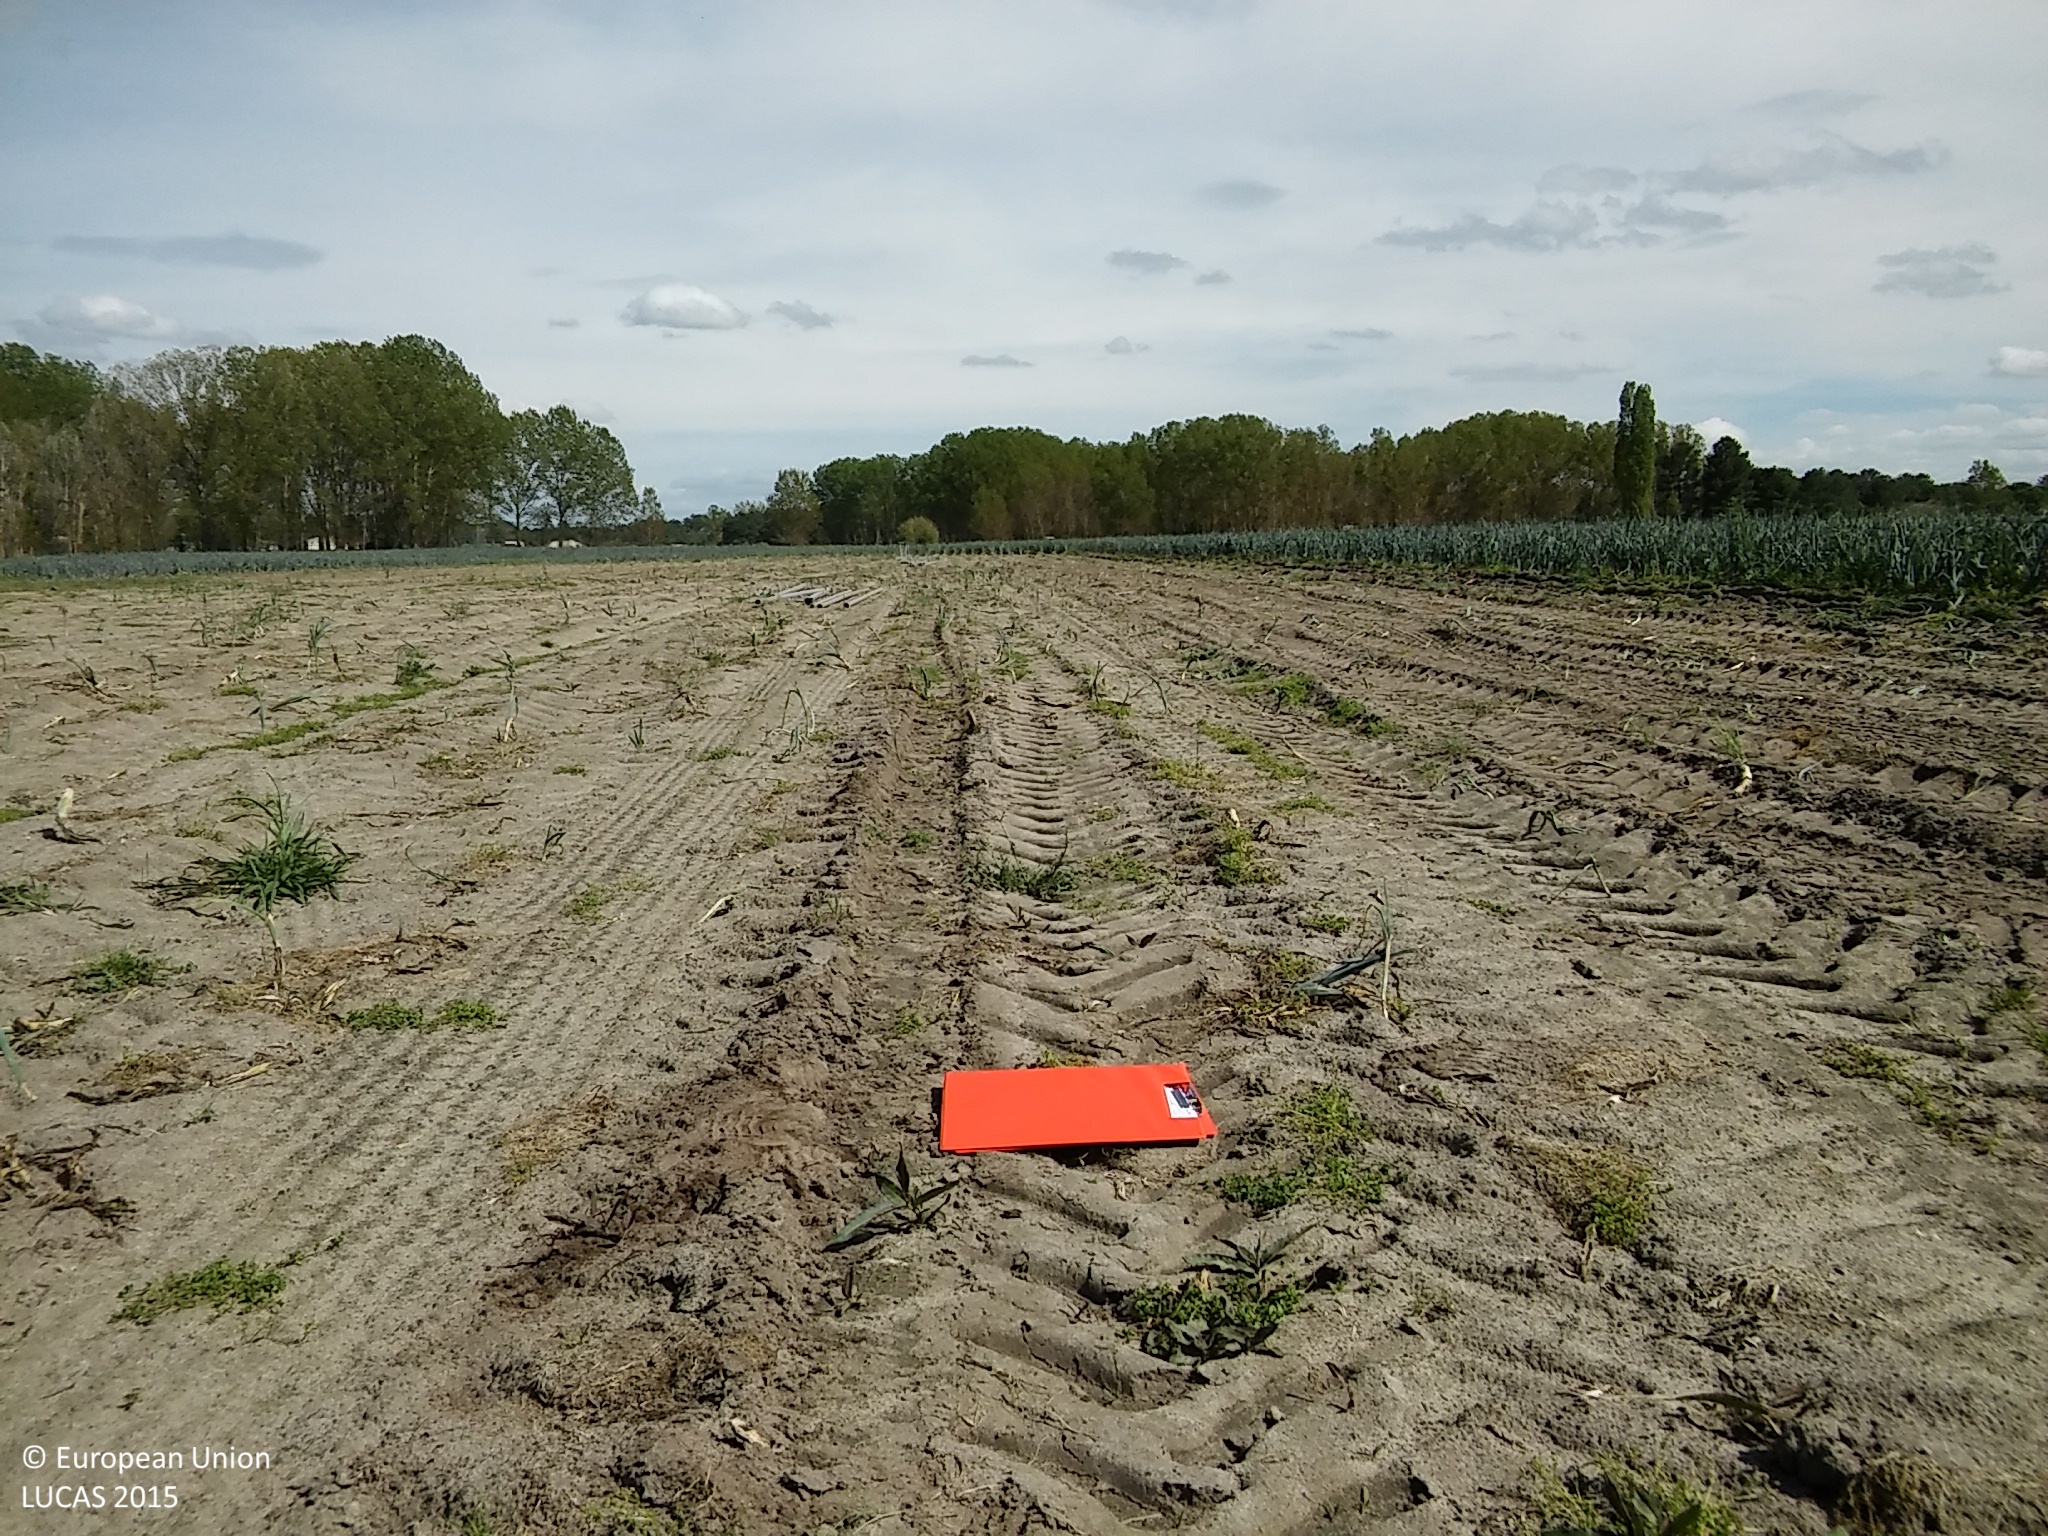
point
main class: Cropland
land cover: Other fresh vegetables
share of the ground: < 10 %
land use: Agriculture (excluding fallow land and kitchen gardens)
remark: Harvested field
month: April
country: ES
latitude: 41.3088
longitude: -4.1376
